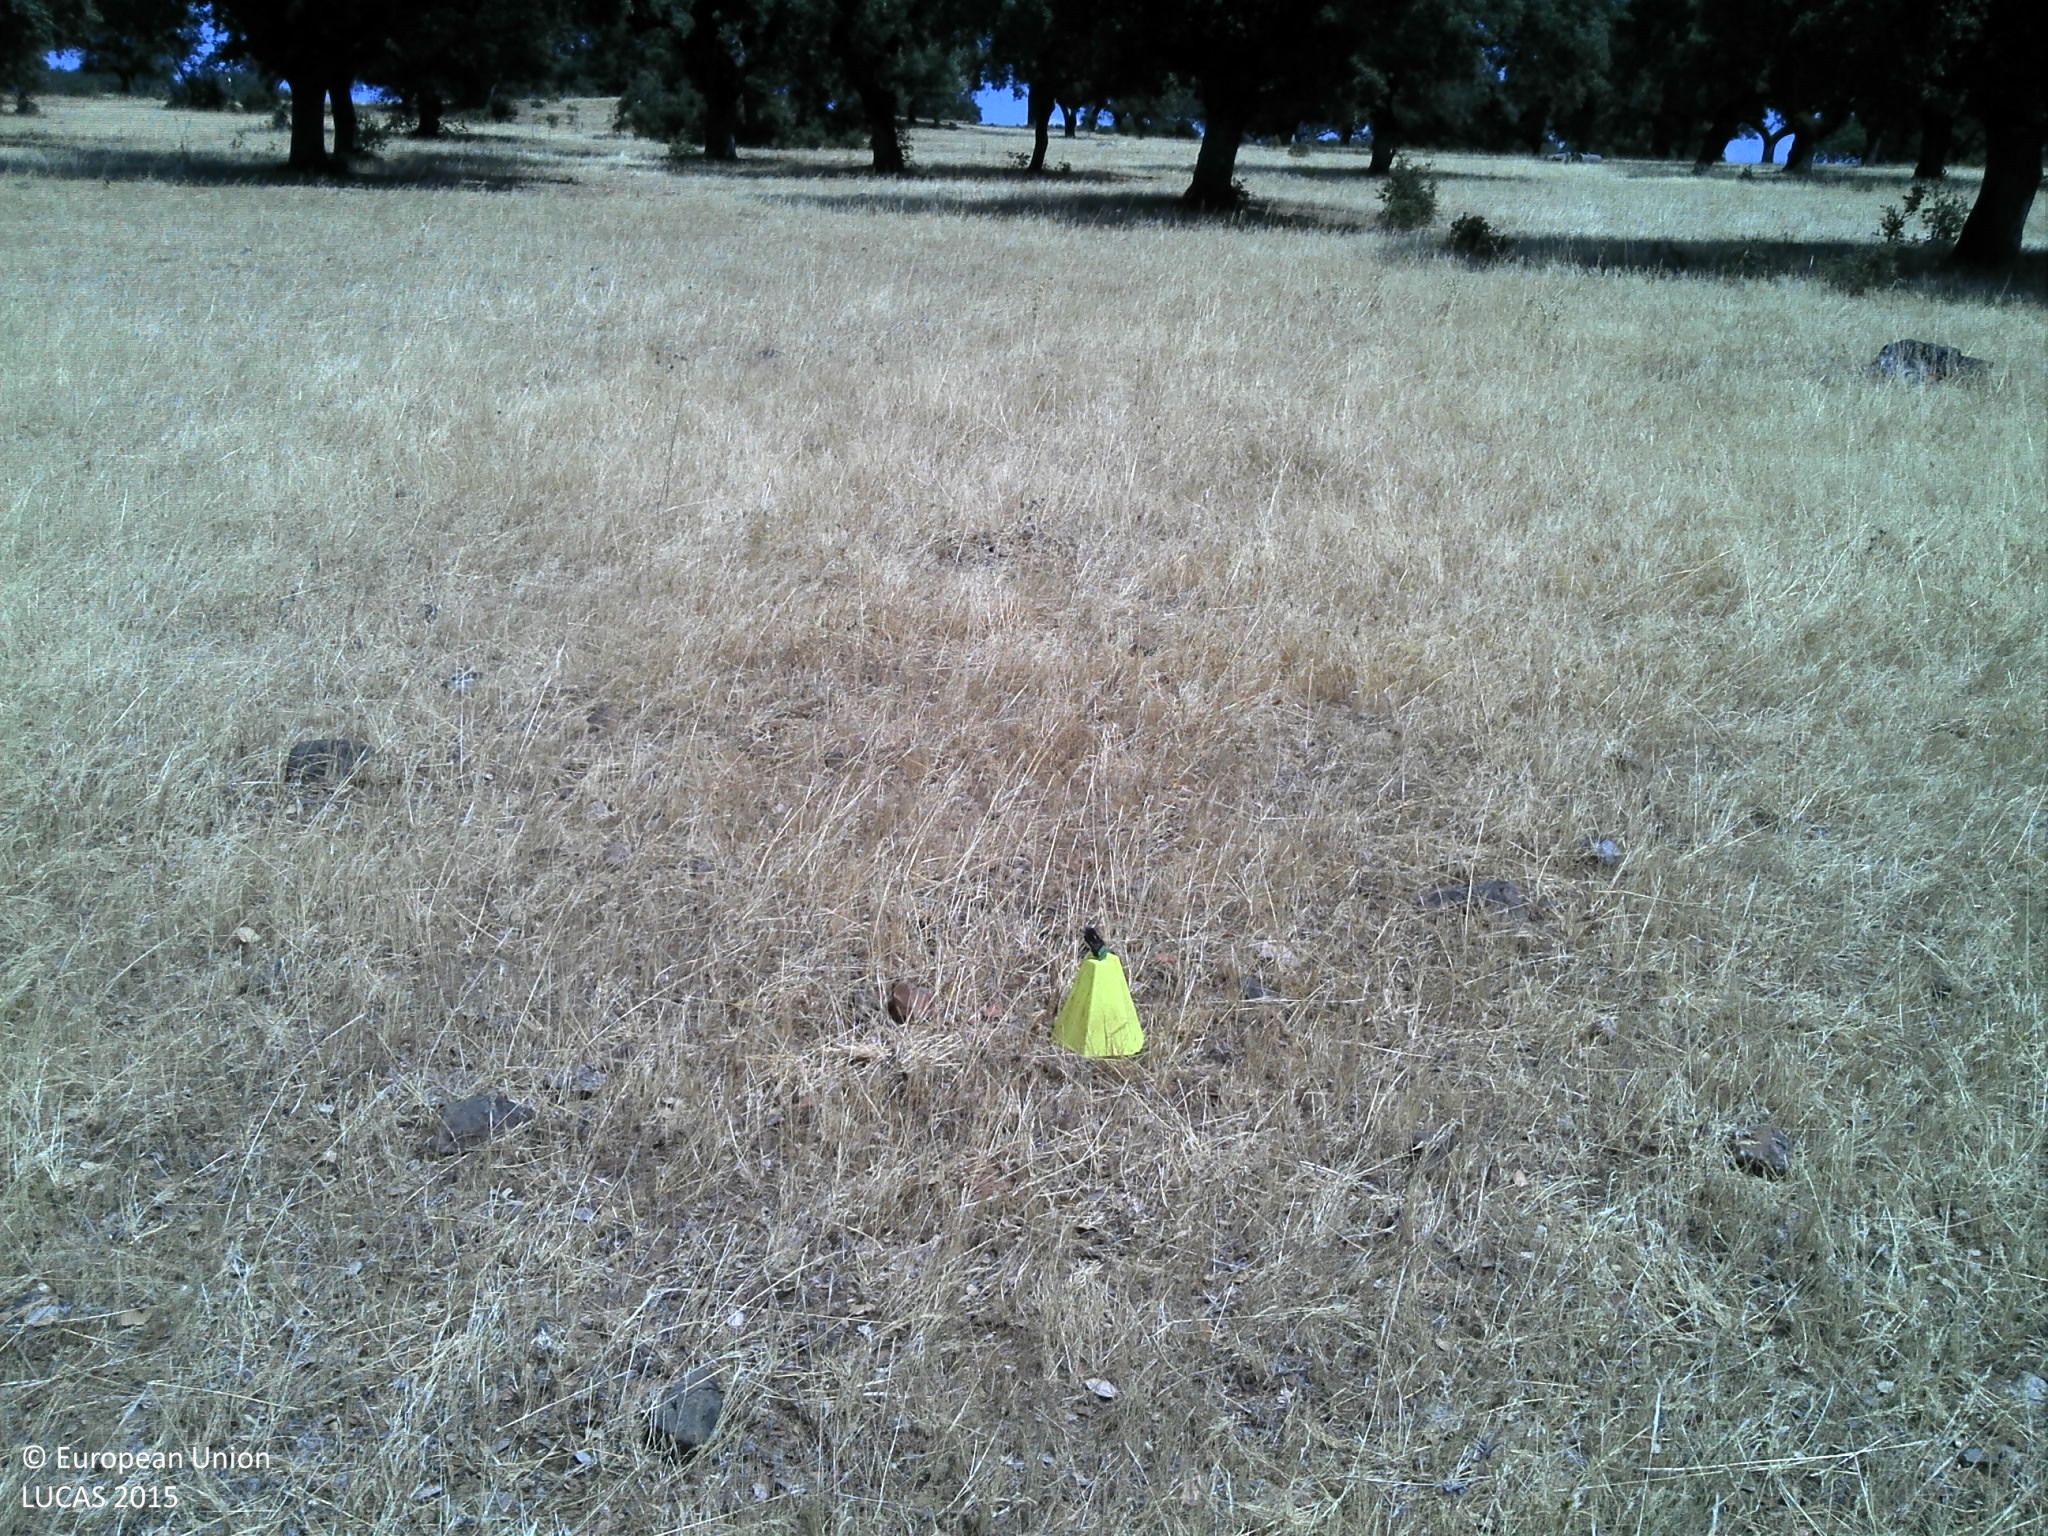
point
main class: Woodland
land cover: Broadleaved woodland
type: broadleaved evergreen forest
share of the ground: 25 - 50 %
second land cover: Grassland without tree/shrub cover
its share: 50 - 75 %
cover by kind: herbaceous plants 65 %, broadleaved forest trees 25 %, unconsolidated bare surface 10 %
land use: Forestry
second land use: Agriculture (excluding fallow land and kitchen gardens)
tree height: > 5 m
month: July
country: PT
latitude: 38.8204
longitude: -7.3418
